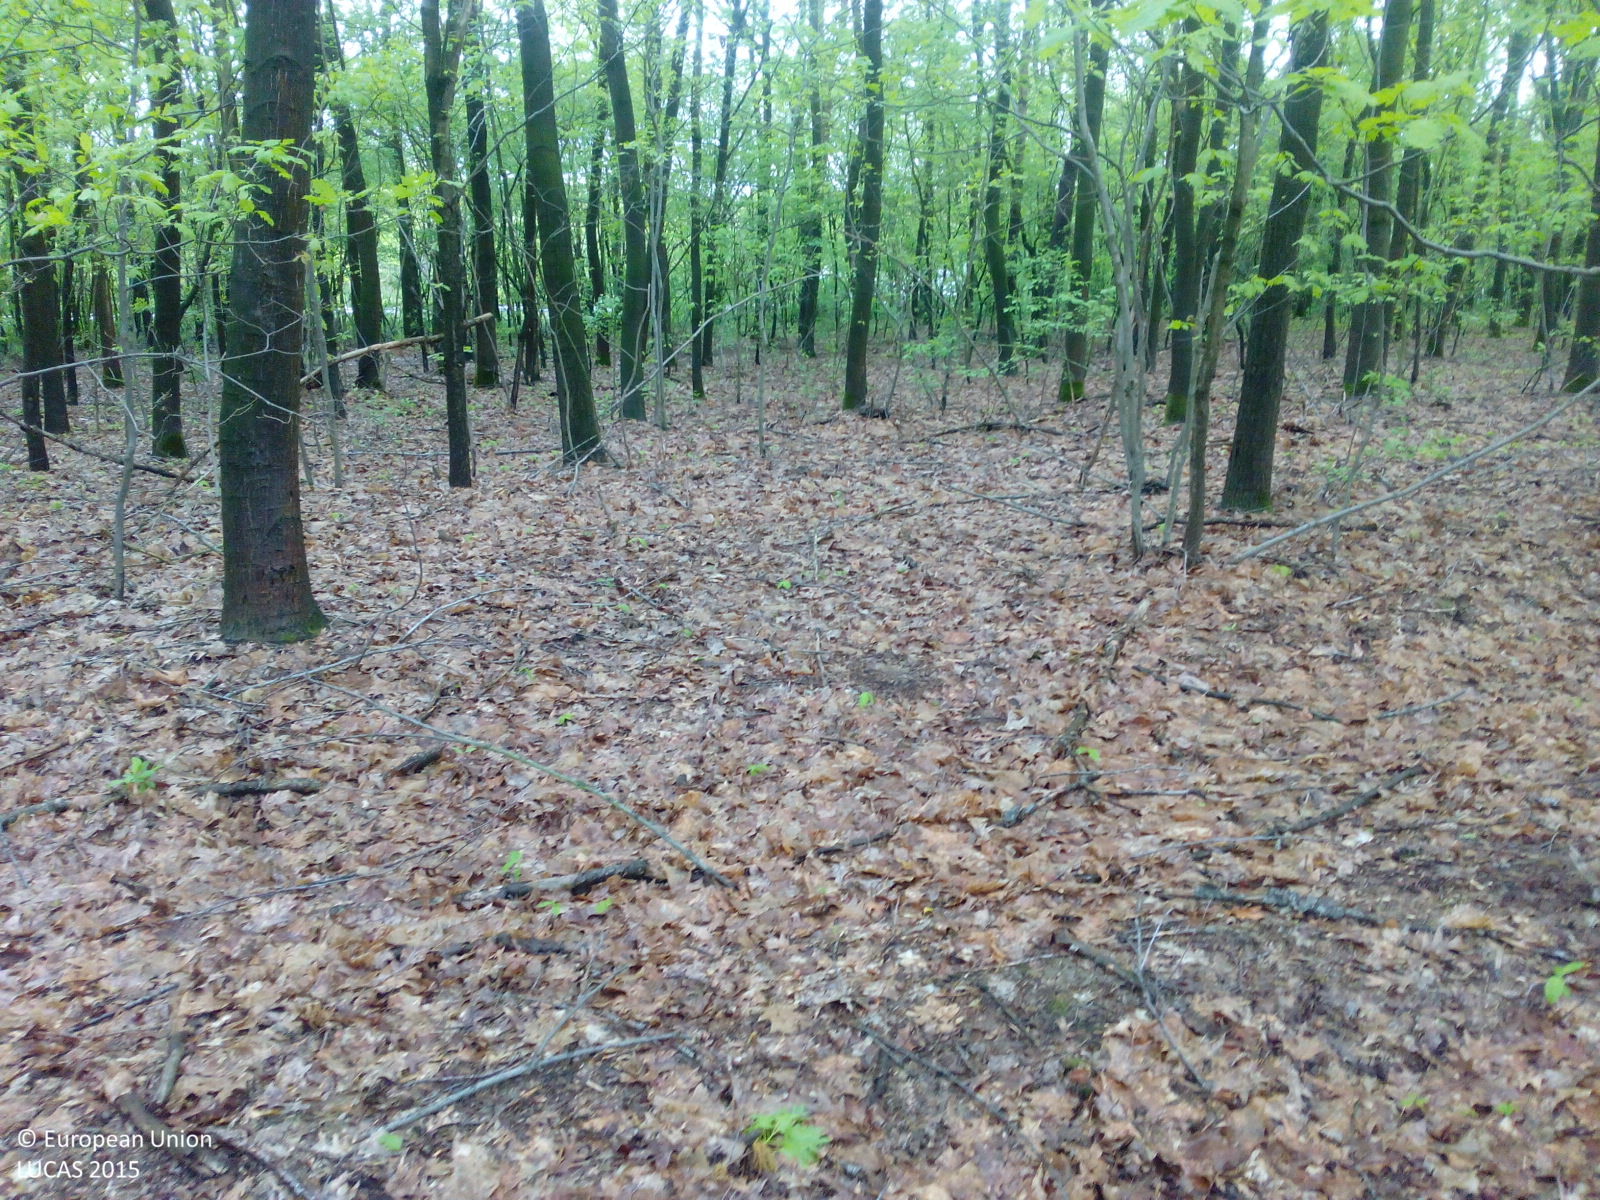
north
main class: Woodland
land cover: Broadleaved woodland
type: mesophytic deciduous forest
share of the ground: > 75 %
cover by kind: broadleaved forest trees 100 %
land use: Amenities, museums, leisure
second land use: Sport
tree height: > 5 m
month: May
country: NL
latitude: 51.4132
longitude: 5.5842
